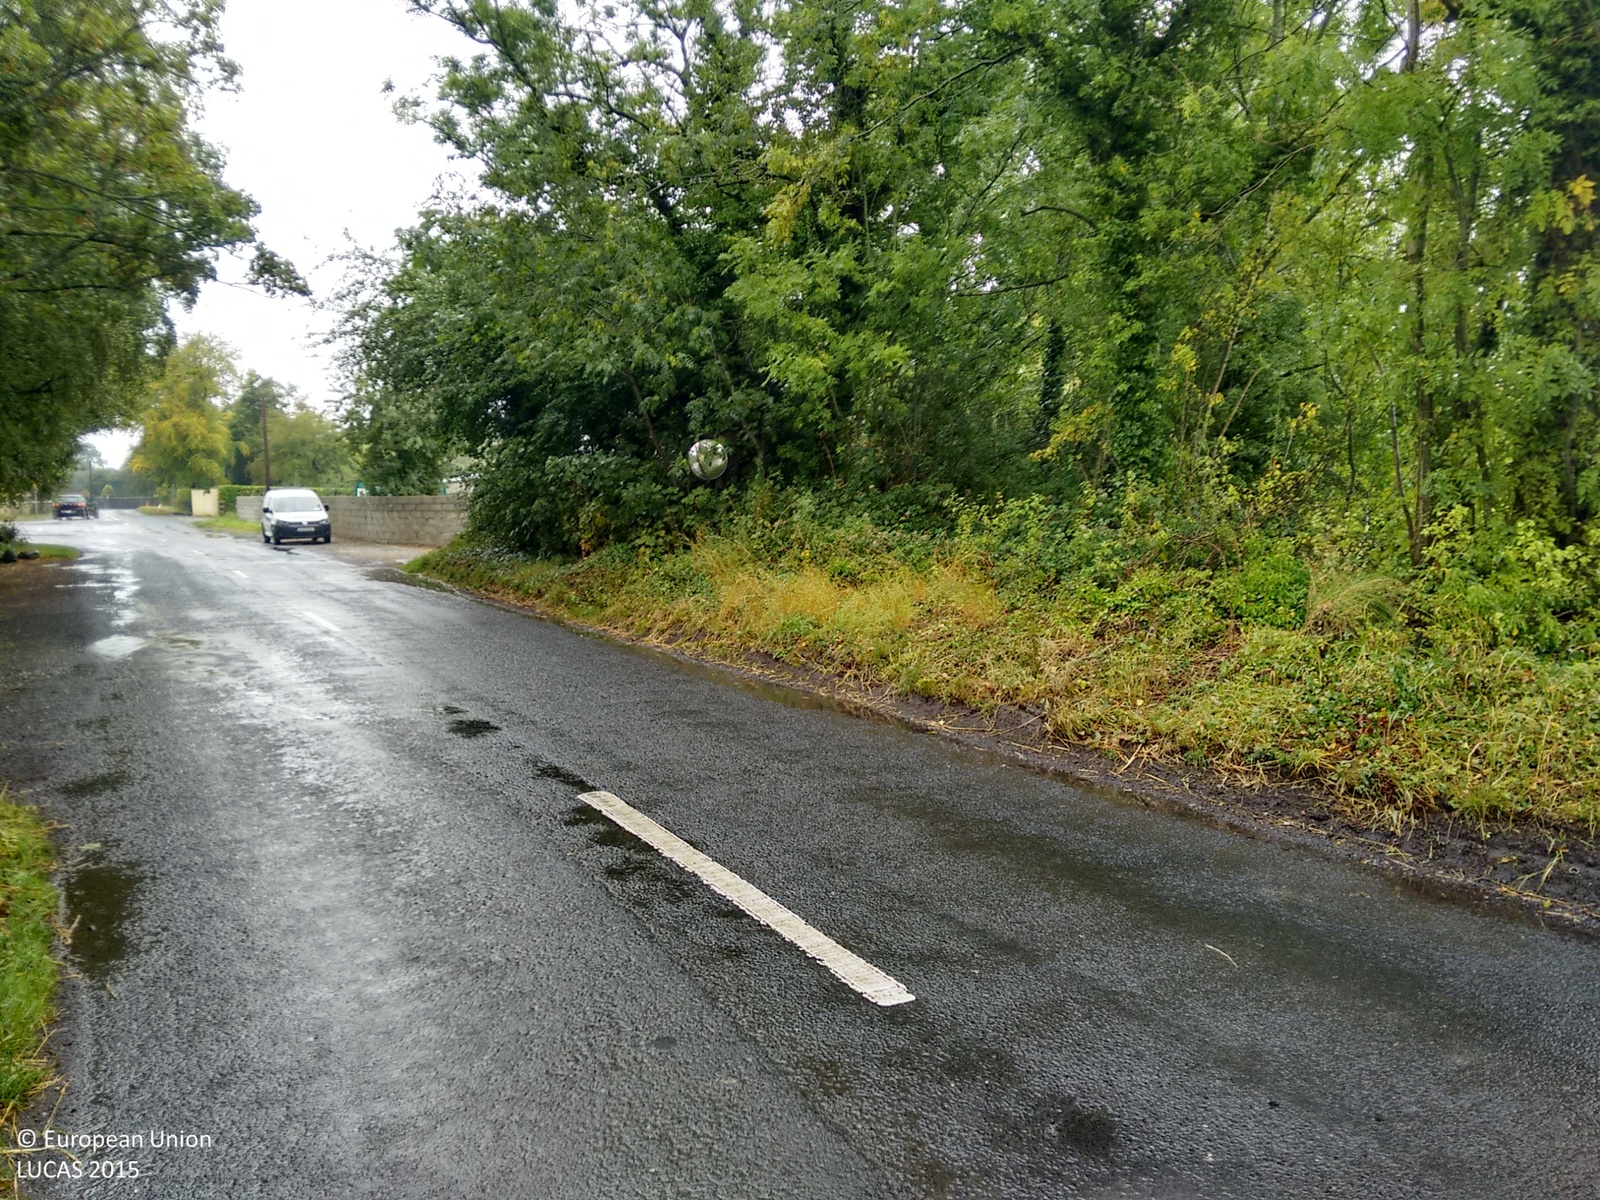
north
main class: Grassland
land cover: Grassland with sparse tree/shrub cover
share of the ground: > 75 %
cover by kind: herbaceous plants 95 %, broadleaved forest trees 5 %
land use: Residential
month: September
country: IE
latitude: 52.5831
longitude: -8.6325
